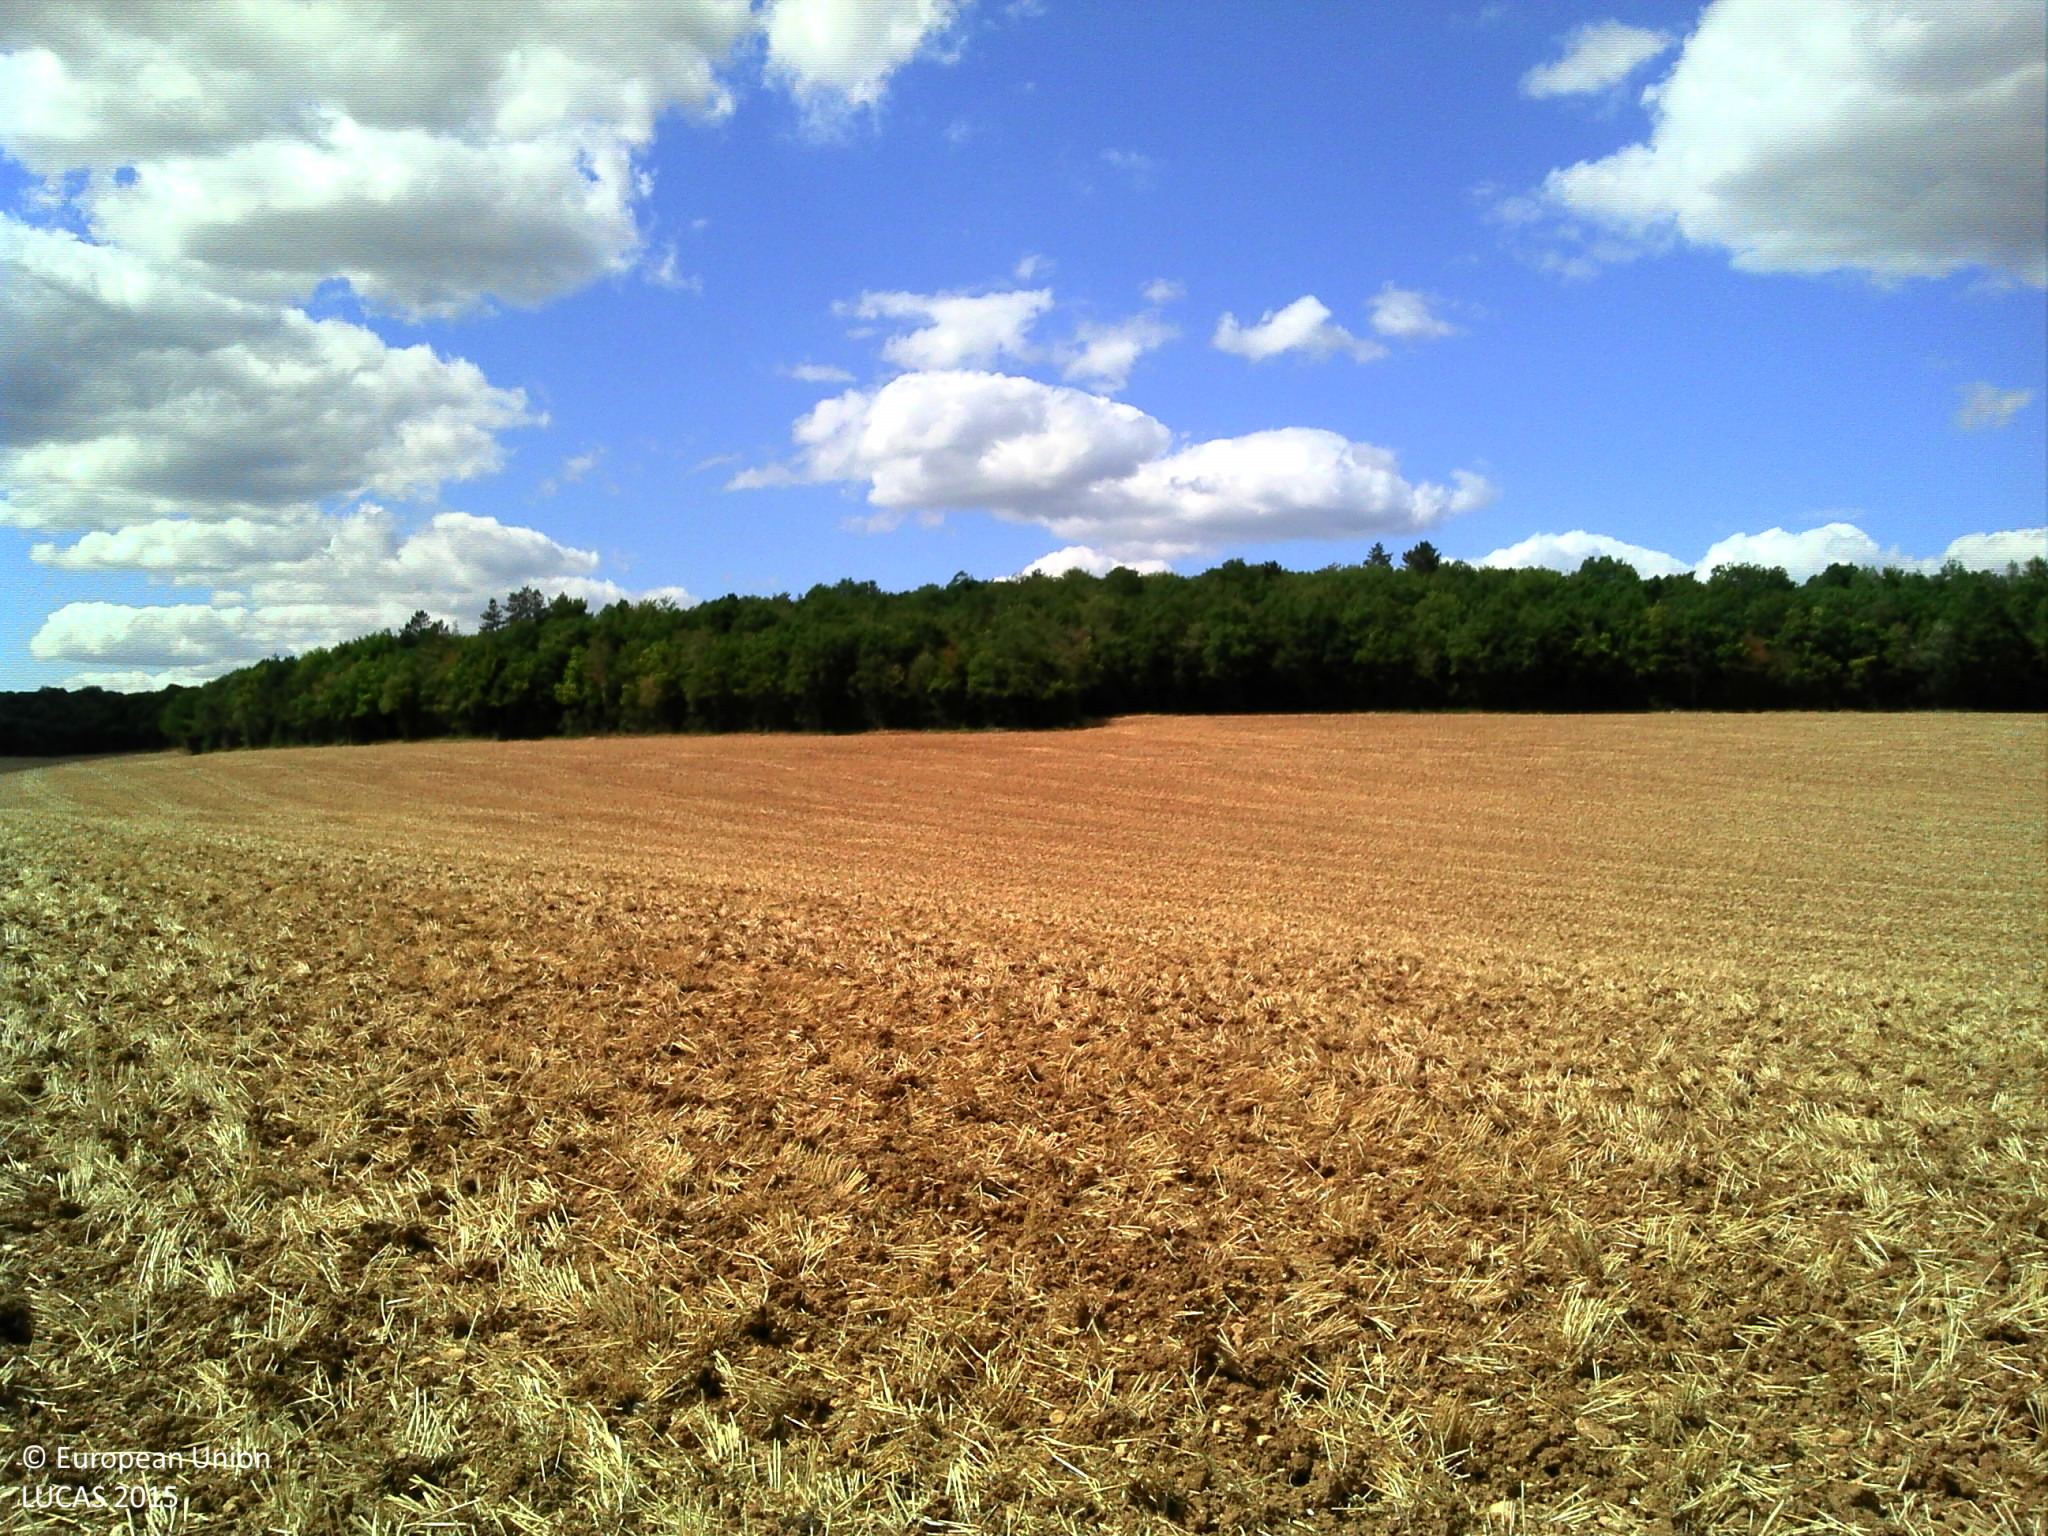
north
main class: Cropland
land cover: Common wheat
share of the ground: 10 - 25 %
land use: Agriculture (excluding fallow land and kitchen gardens)
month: July
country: FR
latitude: 47.6680
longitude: 5.1924
